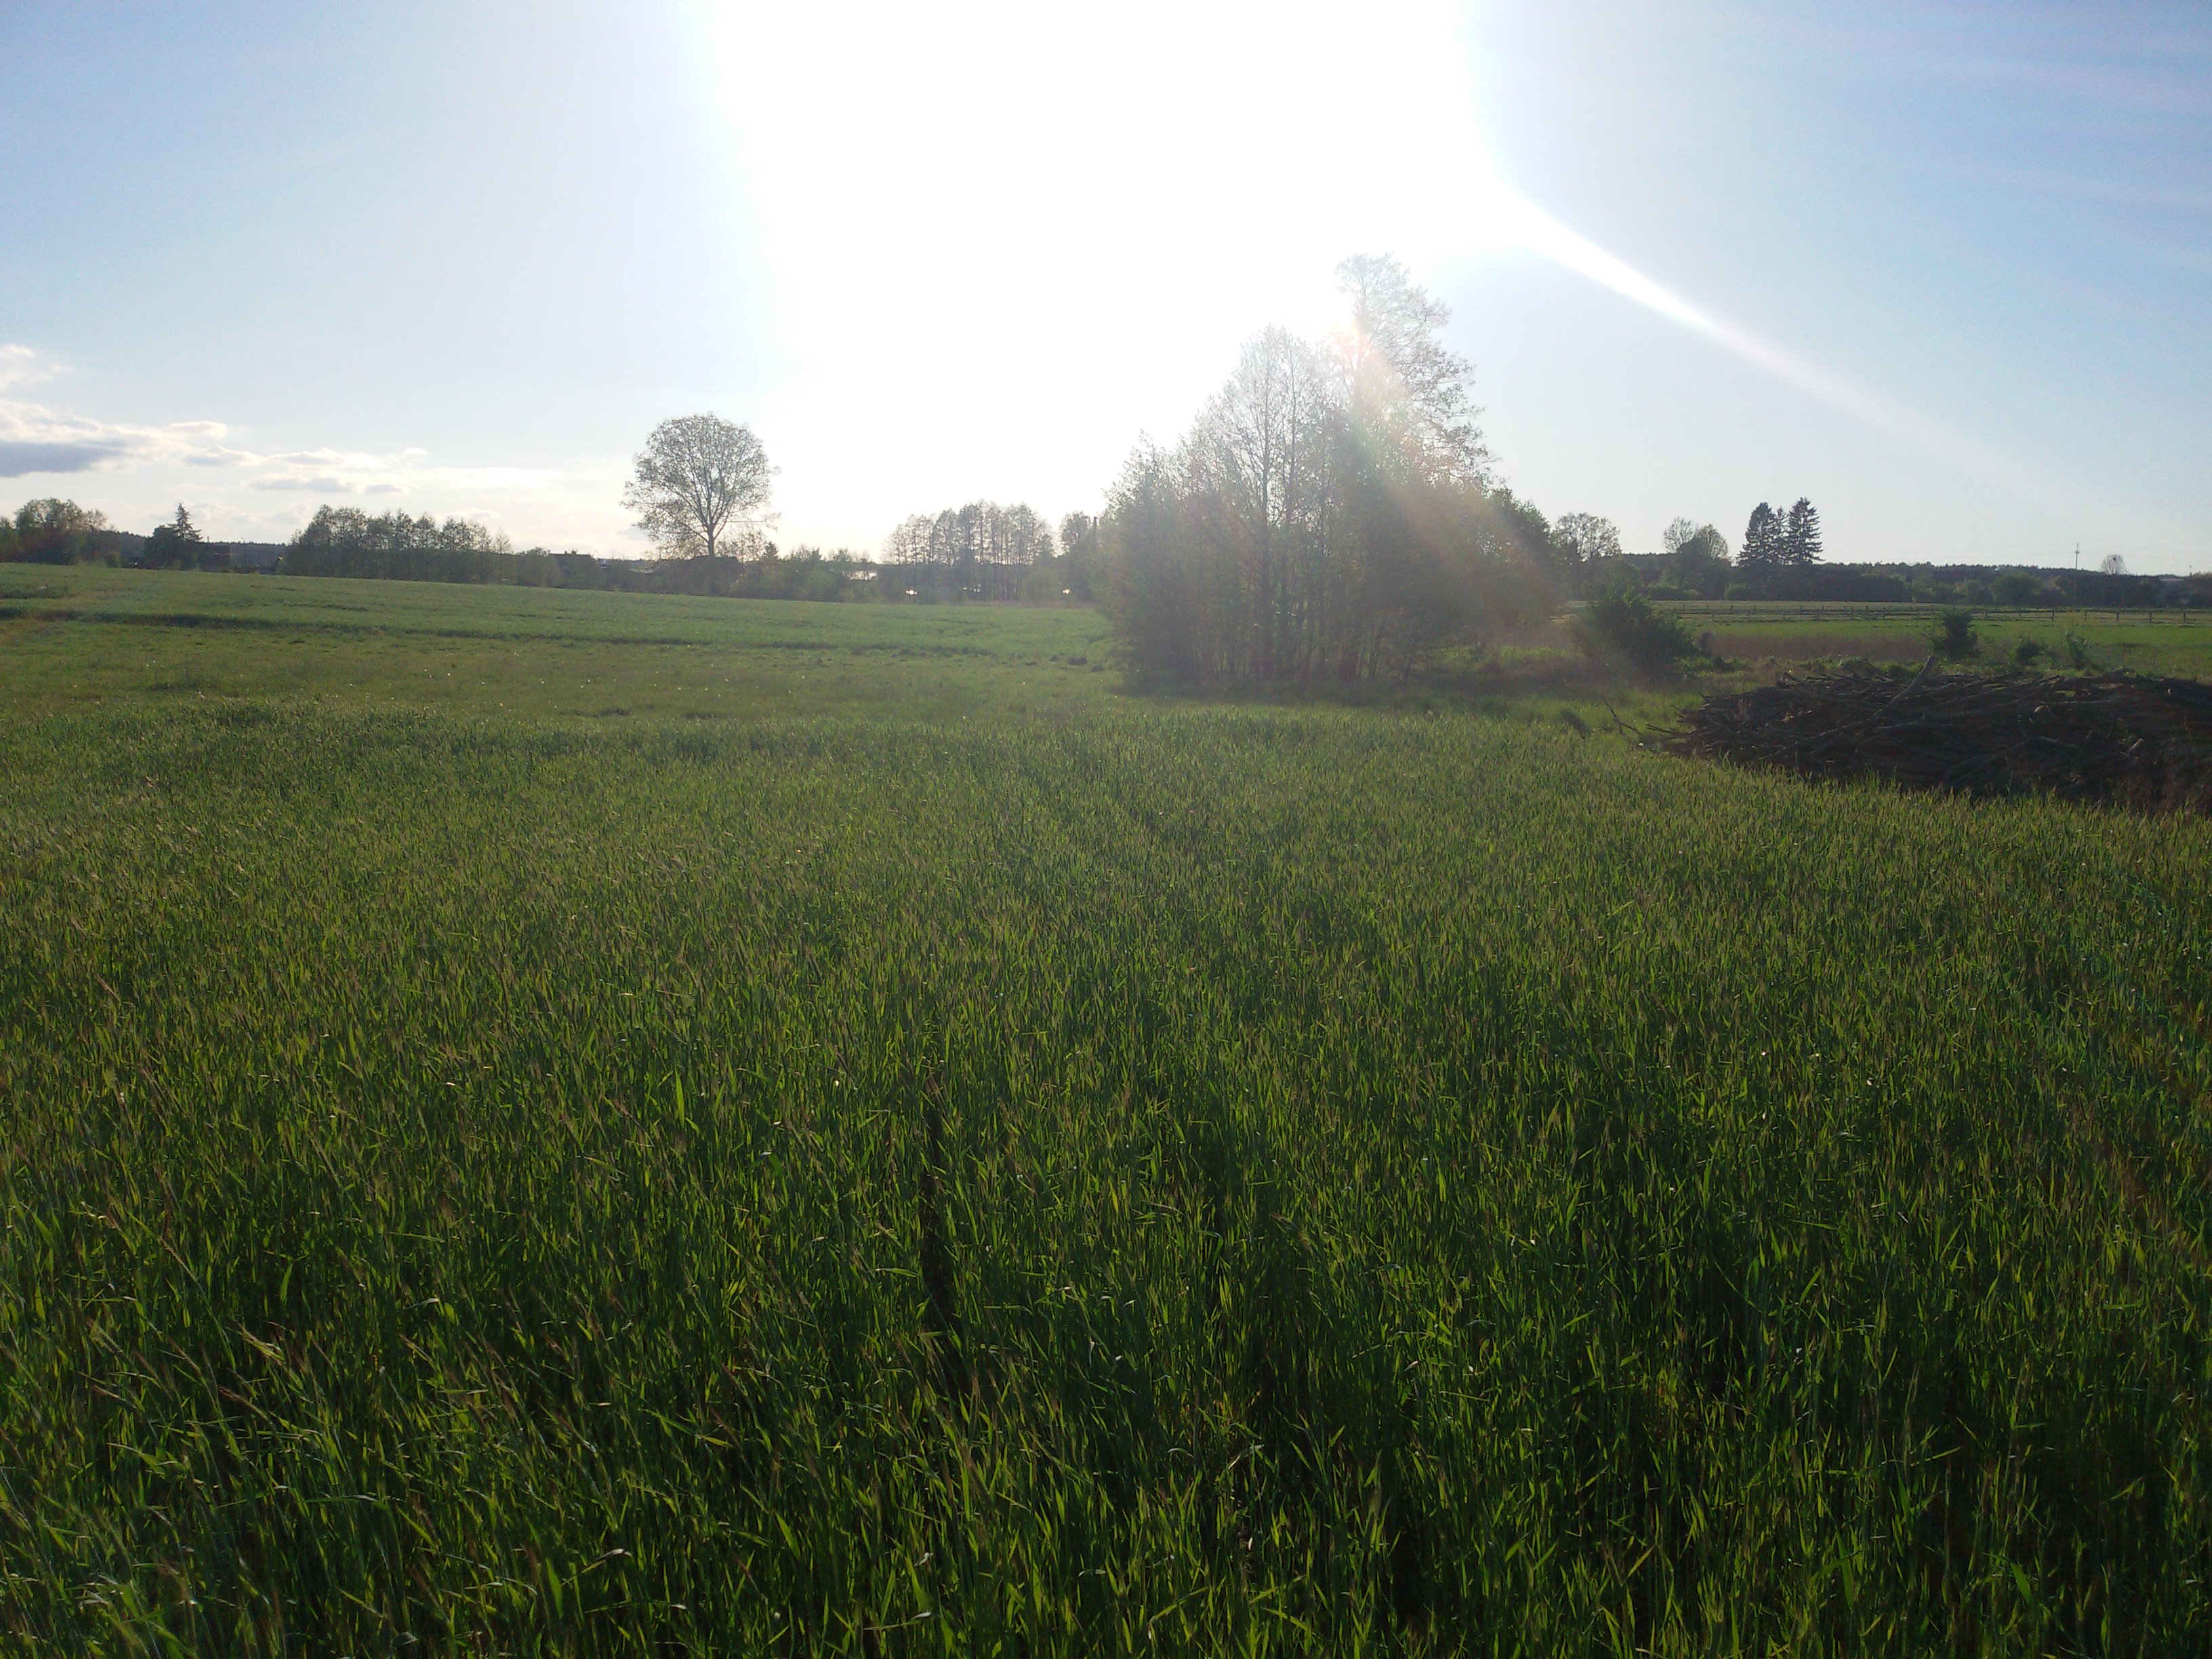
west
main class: Cropland
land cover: Rye
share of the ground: > 75 %
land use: Agriculture (excluding fallow land and kitchen gardens)
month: May
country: PL
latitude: 53.4461
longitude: 17.1012
